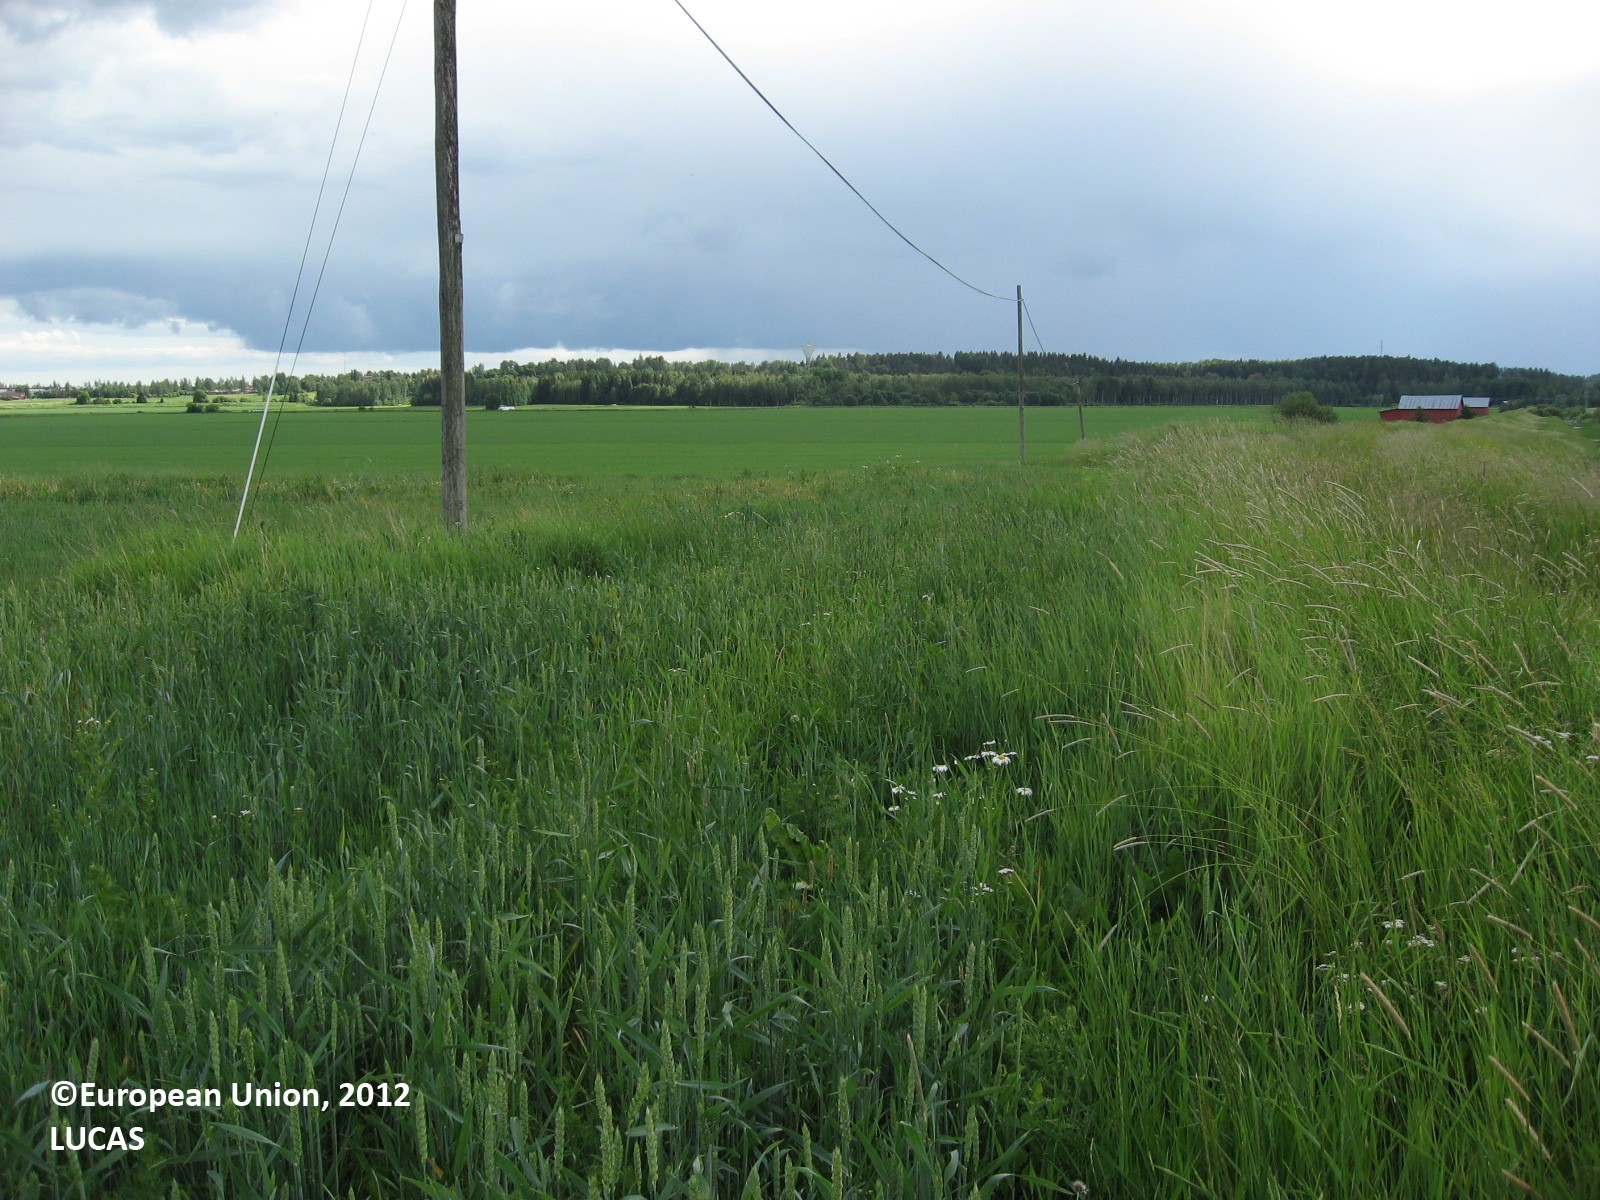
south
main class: Cropland
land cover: Common wheat
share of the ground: > 75 %
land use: Agriculture (excluding fallow land and kitchen gardens)
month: June
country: FI
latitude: 60.7358
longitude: 26.4560
